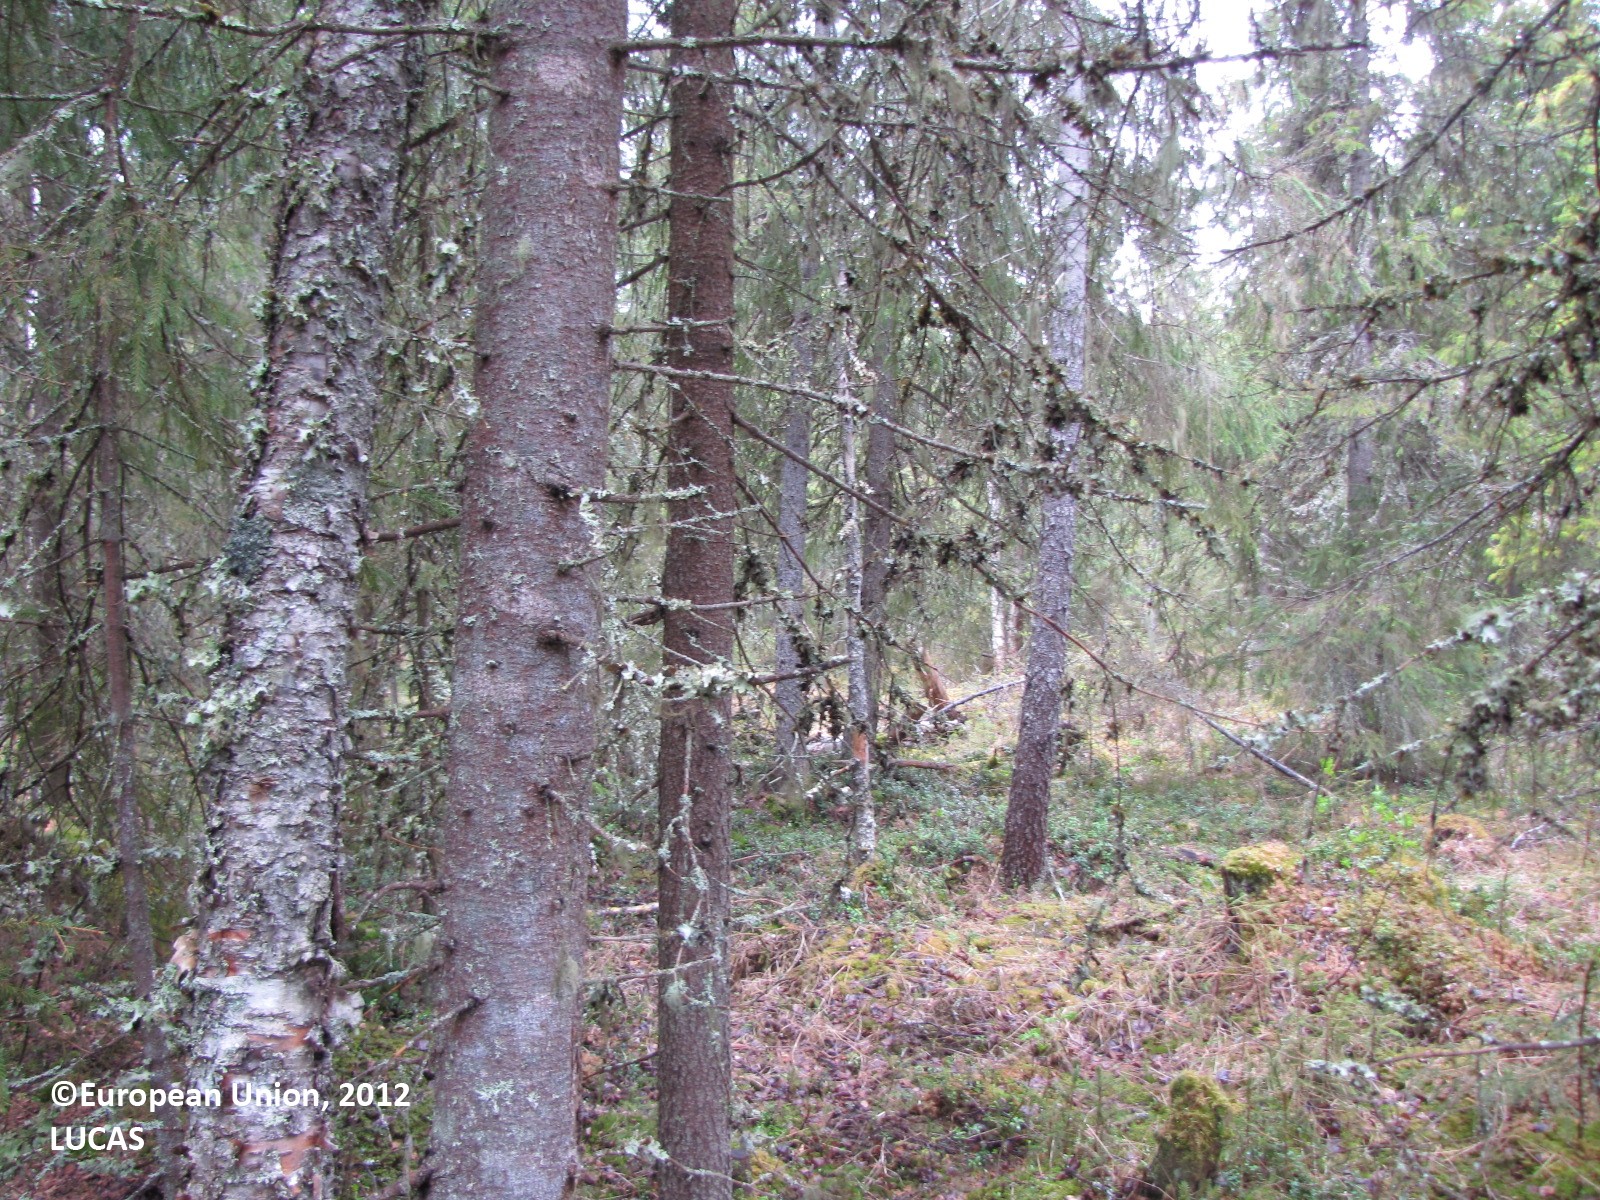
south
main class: Woodland
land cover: Spruce dominated coniferous woodland
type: boreal forest
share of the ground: 50 - 75 %
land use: Forestry
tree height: > 5 m
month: June
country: FI
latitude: 65.9556
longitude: 24.5473
